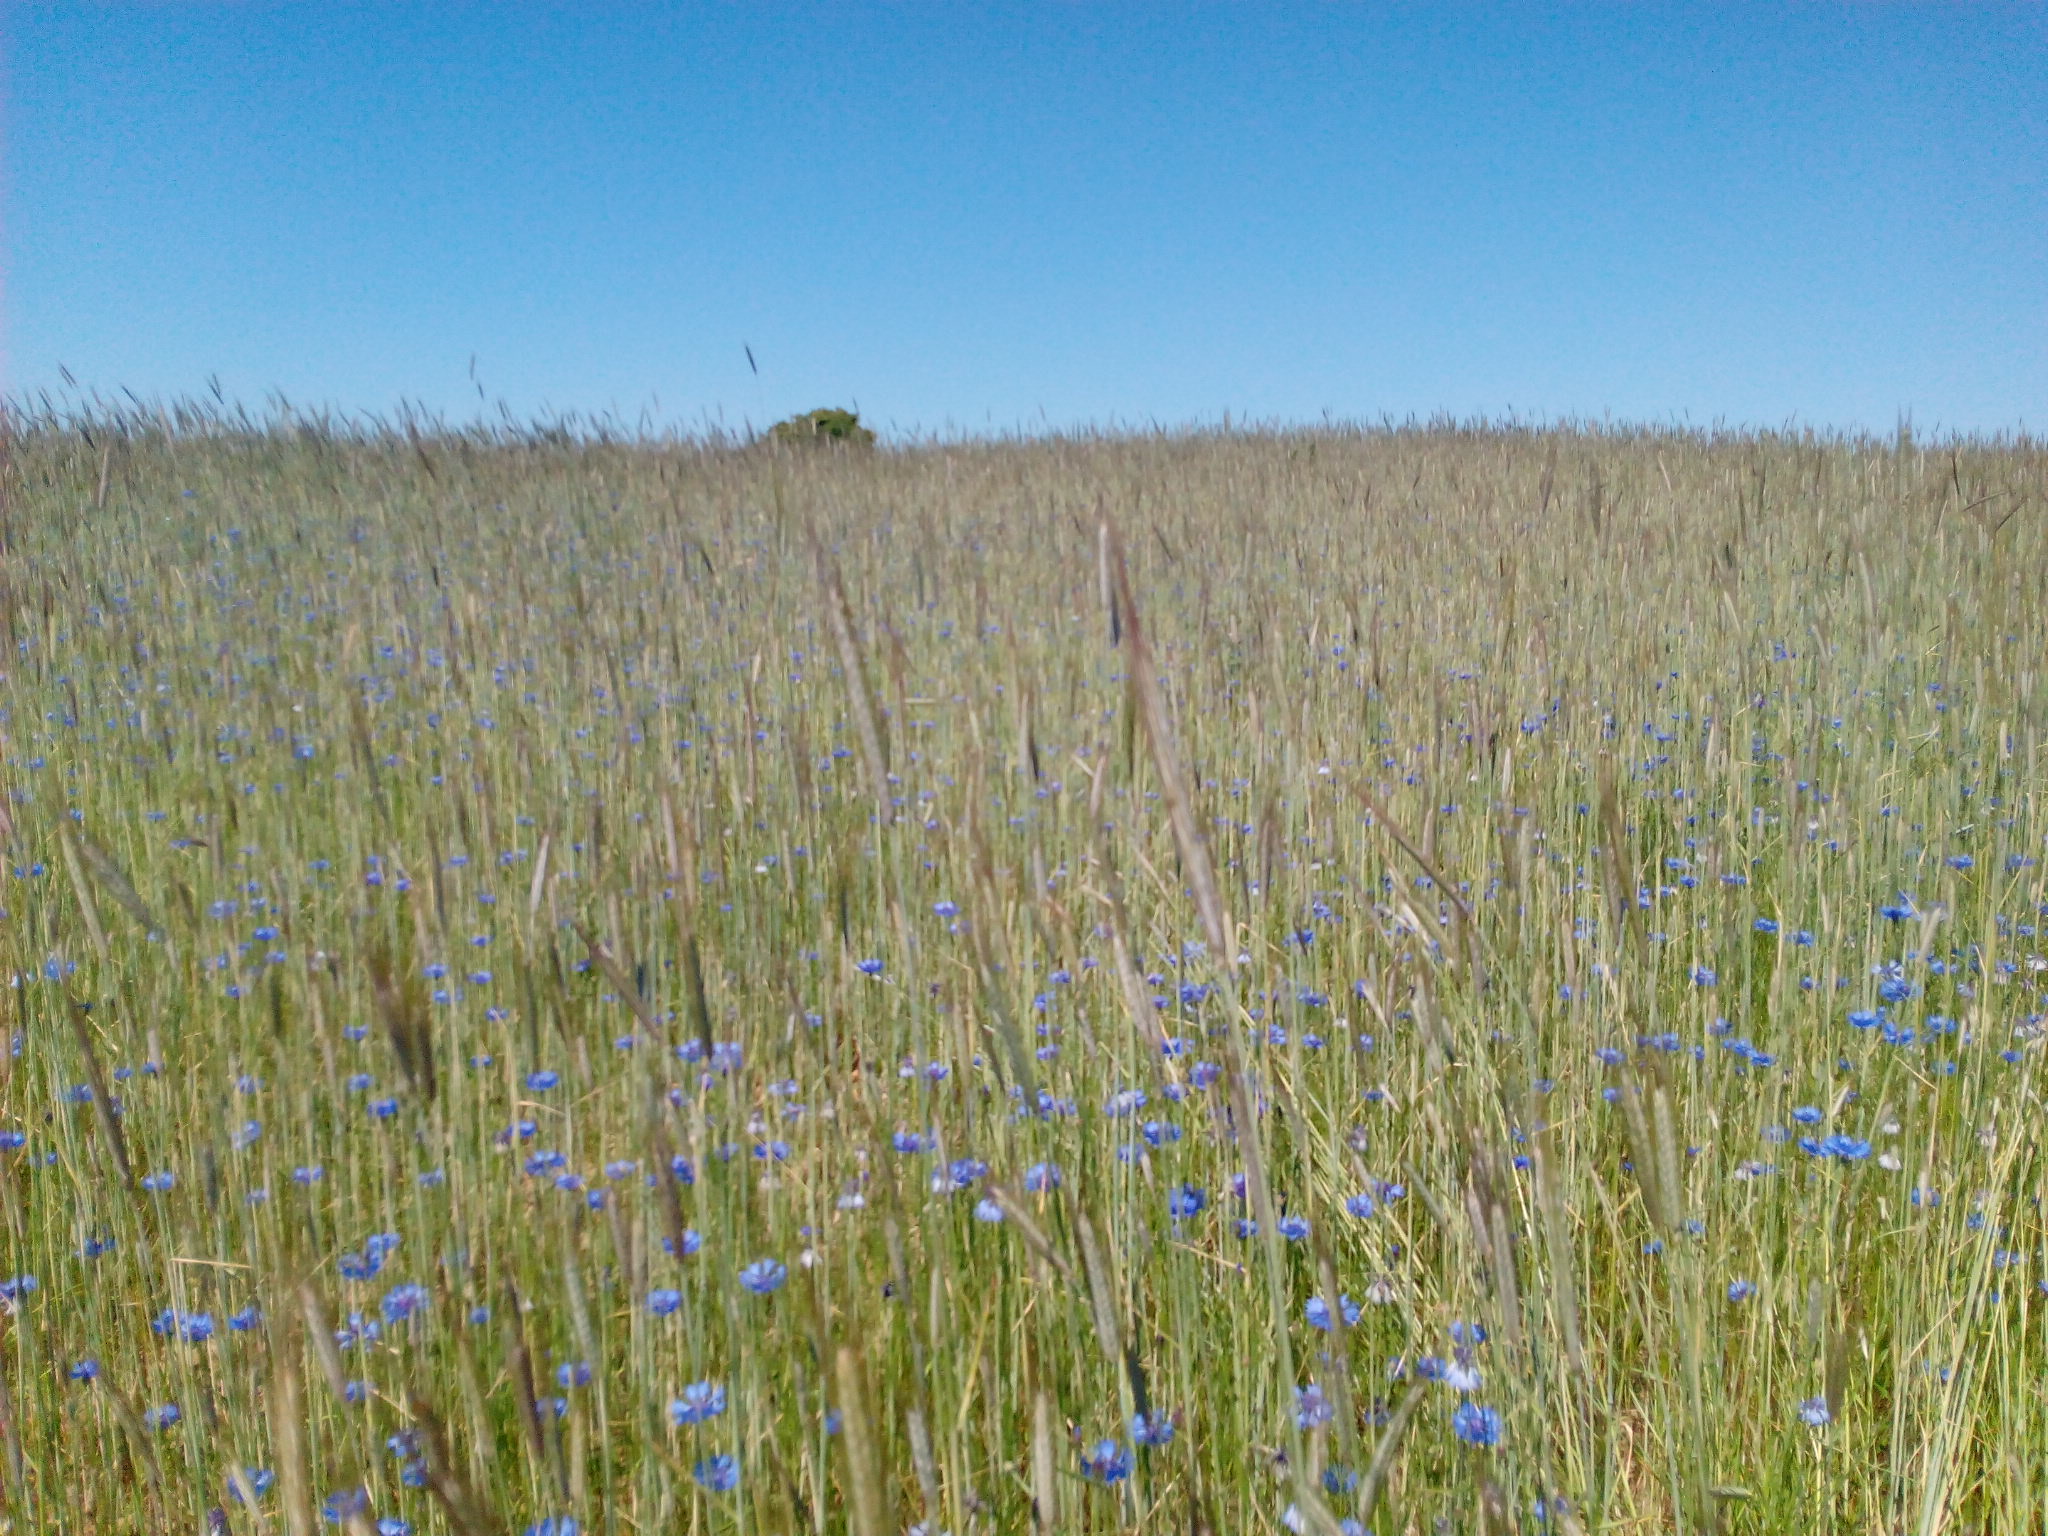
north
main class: Cropland
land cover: Mixed cereals for fodder
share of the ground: > 75 %
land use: Agriculture (excluding fallow land and kitchen gardens)
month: June
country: DE
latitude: 53.1496
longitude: 13.6335
